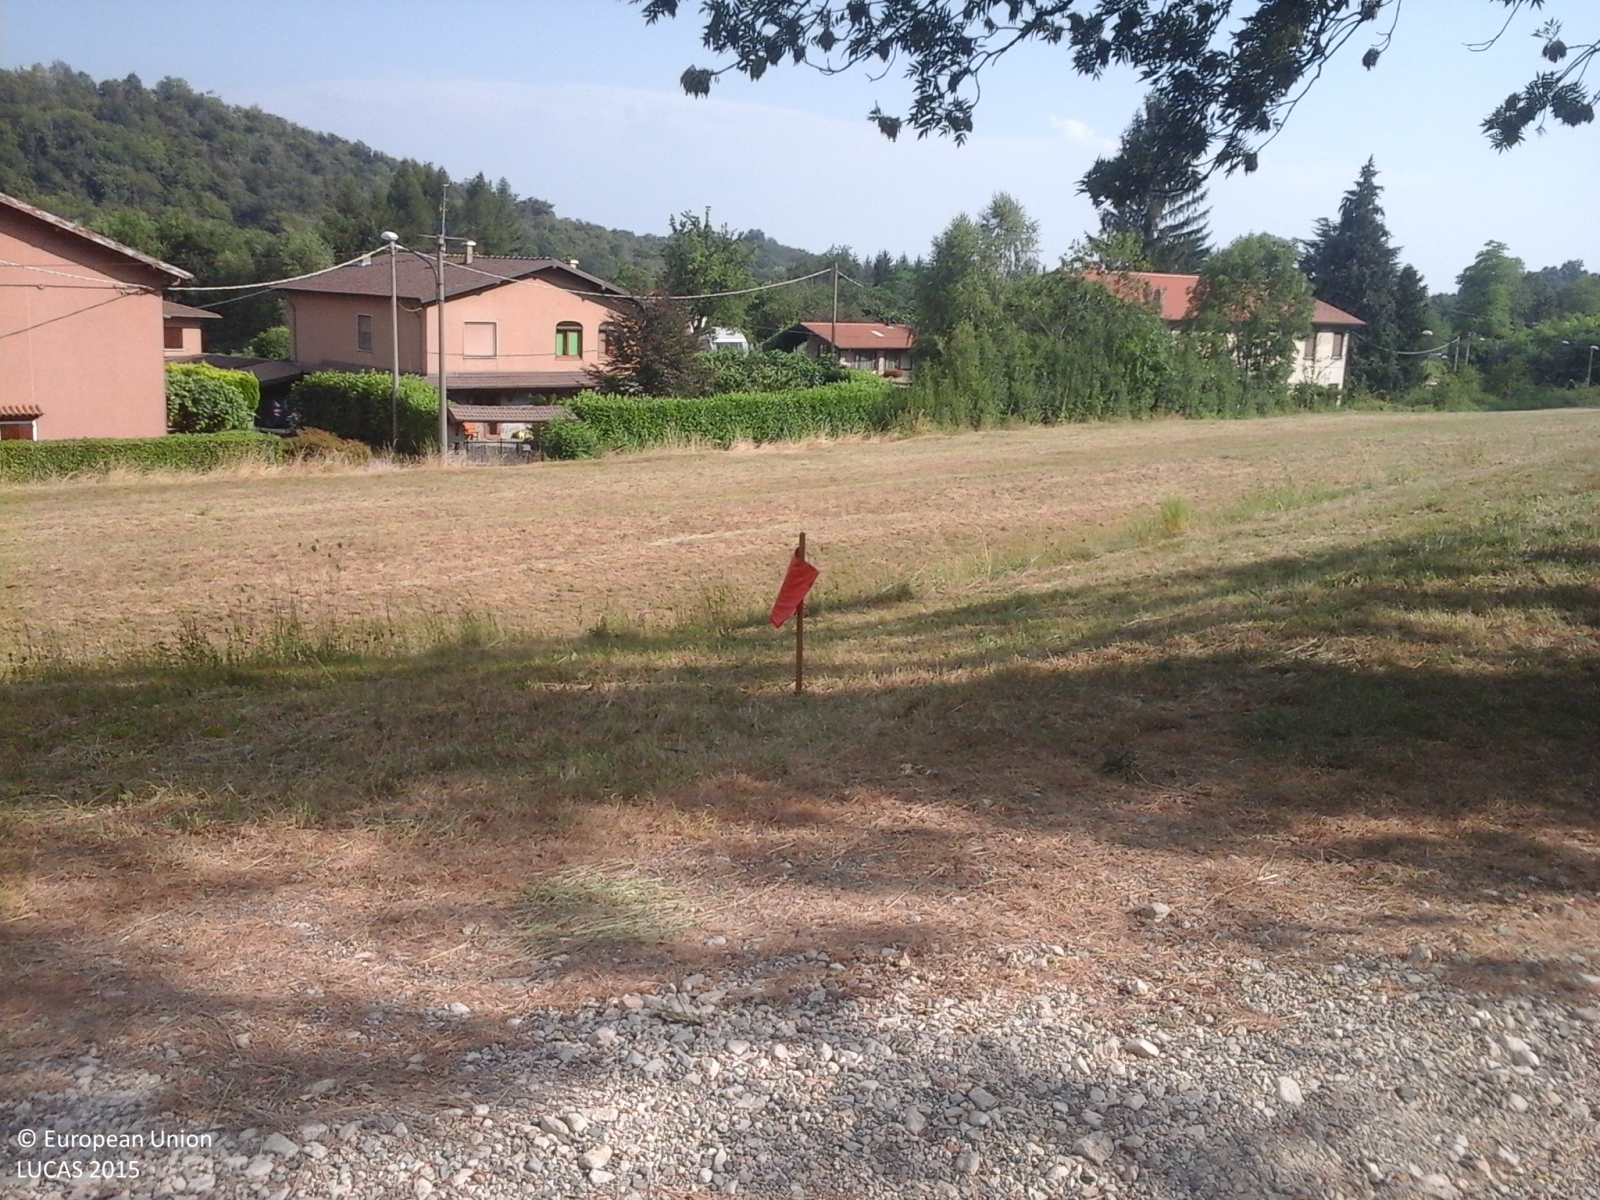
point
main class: Grassland
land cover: Grassland without tree/shrub cover
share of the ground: > 75 %
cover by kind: herbaceous plants 100 %
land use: Agriculture (excluding fallow land and kitchen gardens)
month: July
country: IT
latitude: 45.8581
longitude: 8.8040
